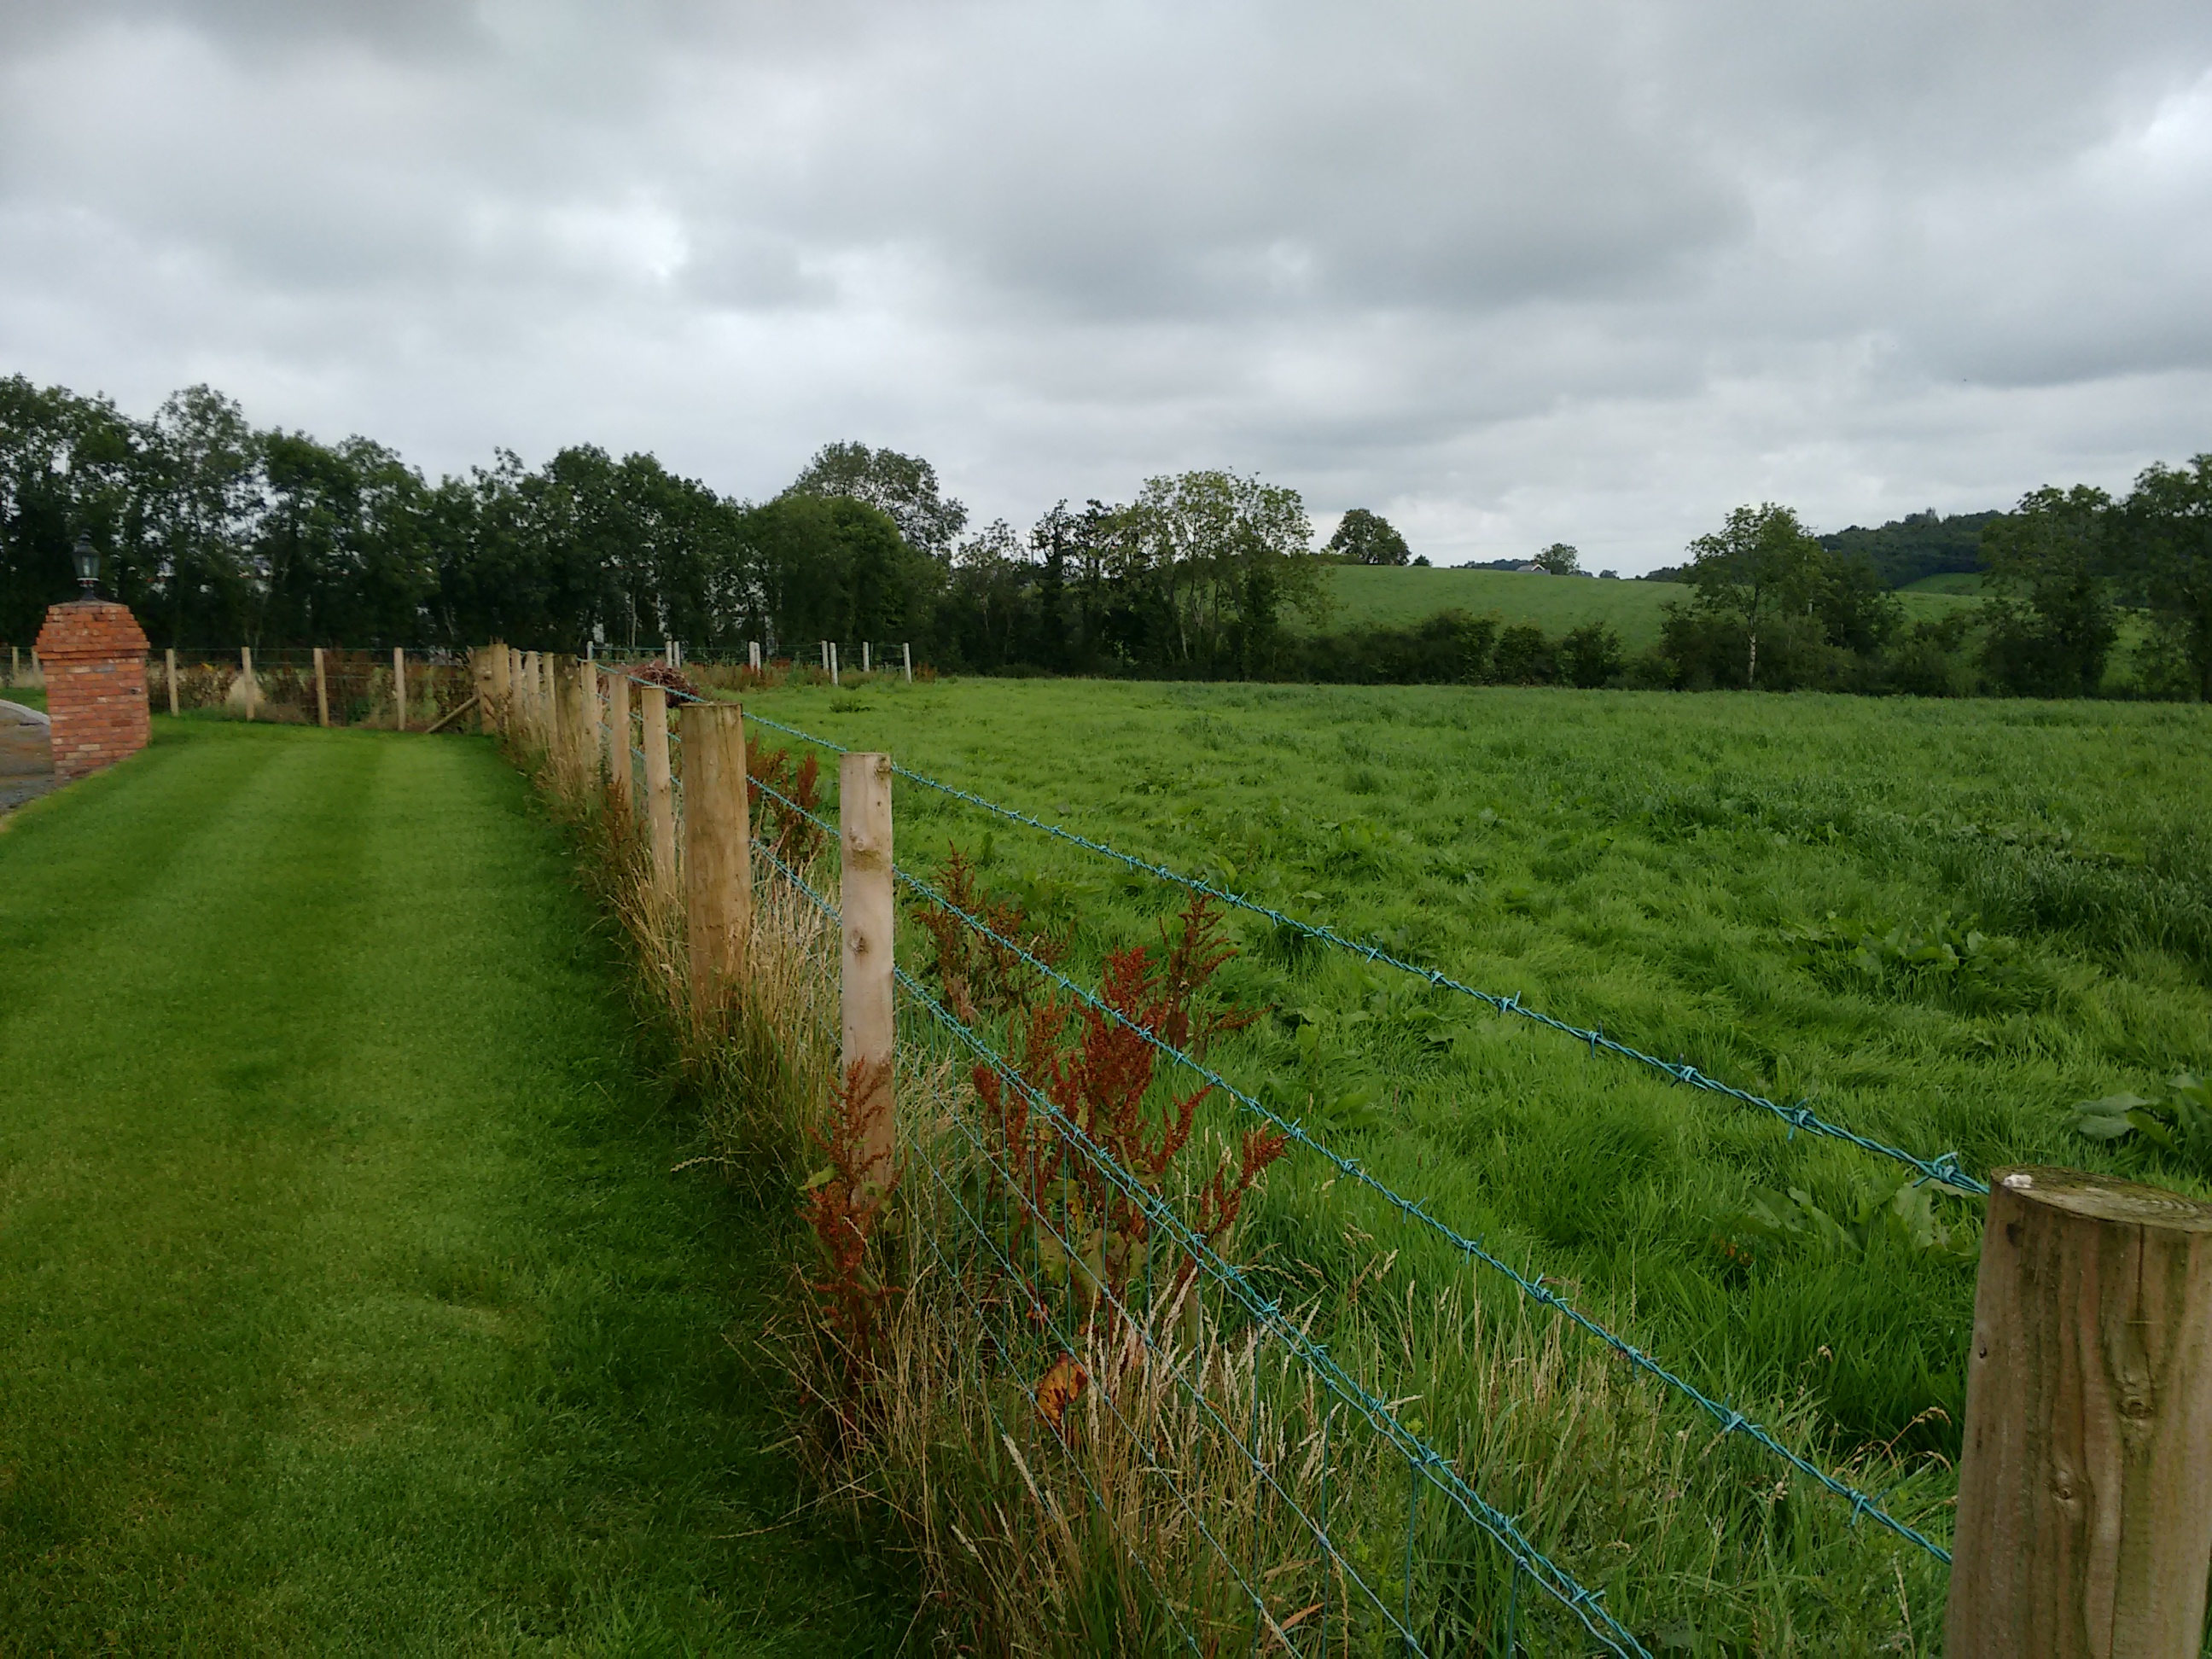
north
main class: Grassland
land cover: Grassland without tree/shrub cover
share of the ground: > 75 %
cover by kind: herbaceous plants 100 %
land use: Agriculture (excluding fallow land and kitchen gardens)
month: August
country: GB
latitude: 54.4109
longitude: -6.7574
